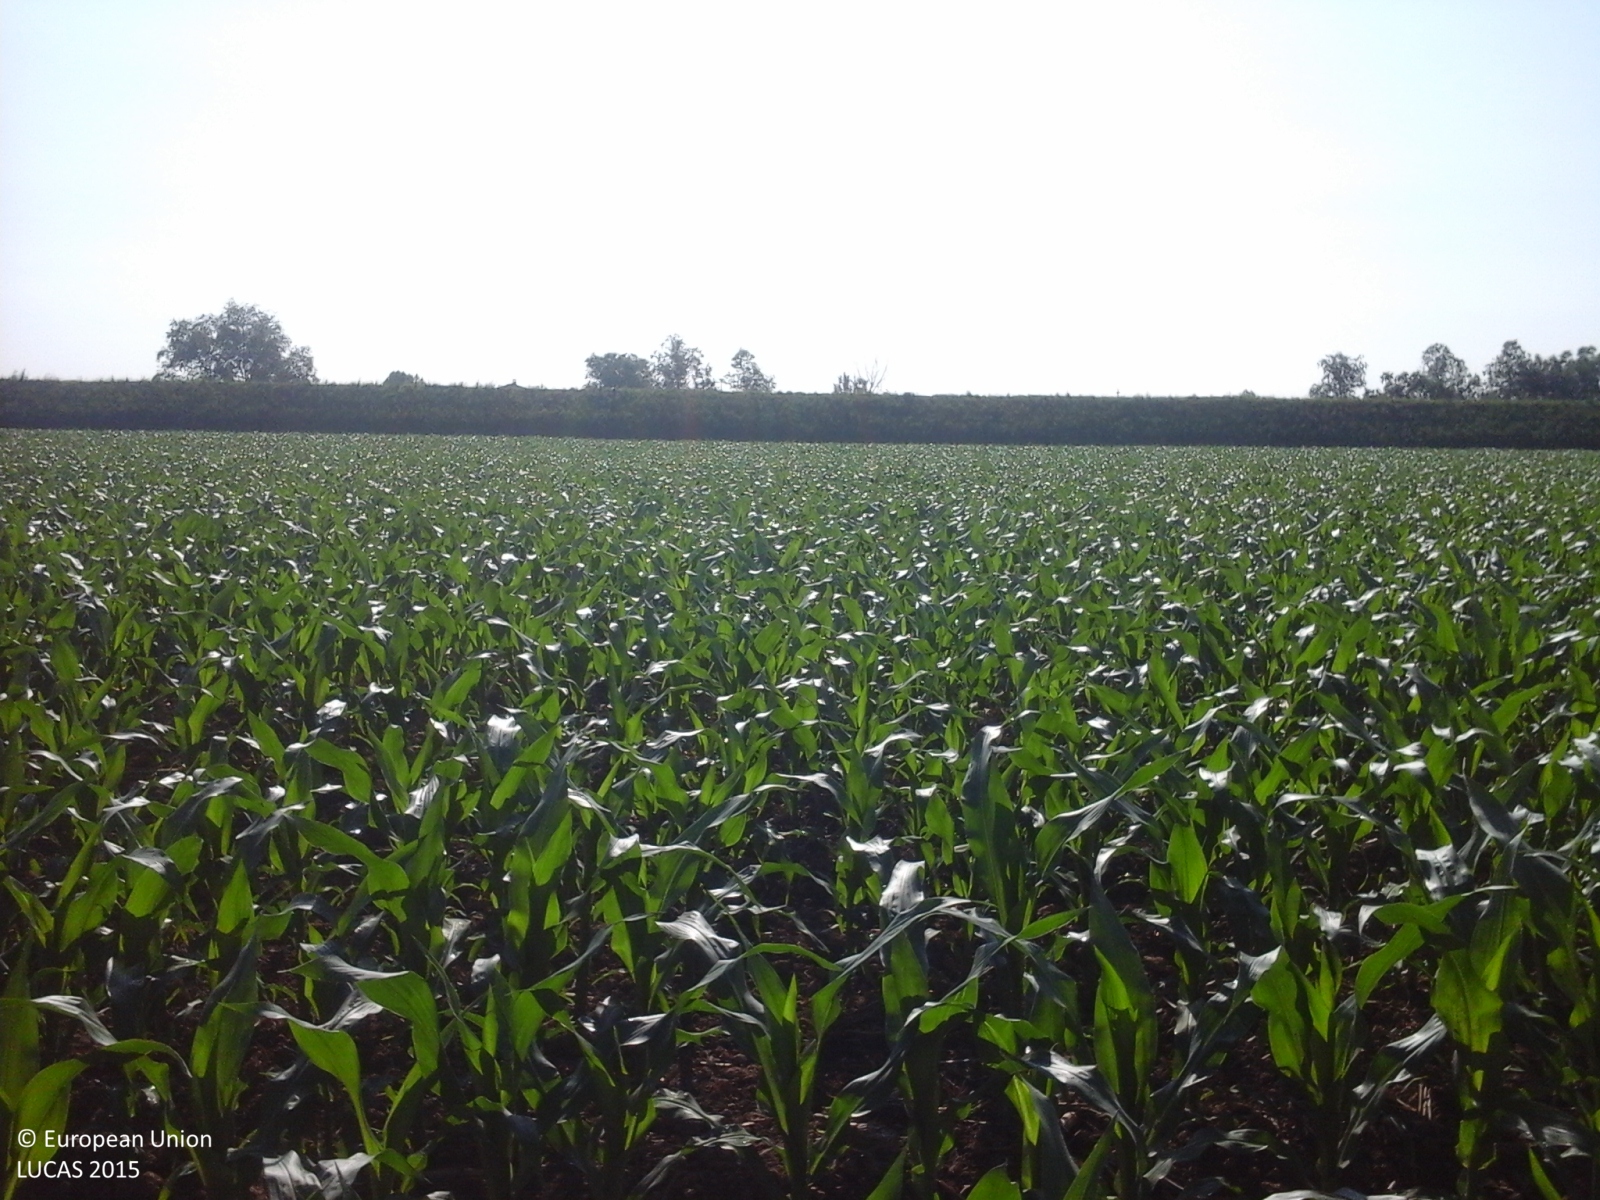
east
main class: Cropland
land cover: Maize
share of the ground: 50 - 75 %
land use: Agriculture (excluding fallow land and kitchen gardens)
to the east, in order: Maize; Grassland without tree/shrub cover; Tracks; Grassland without tree/shrub cover; Shrubland with sparse tree cover; Inland fresh running water; Shrubland with sparse tree cover; Spontaneously vegetated surfaces; Grassland without tree/shrub cover; Tracks; Grassland without tree/shrub cover; Lines of trees; Ditches and canals; Lines of trees
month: May
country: IT
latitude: 45.5640
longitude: 11.6245
